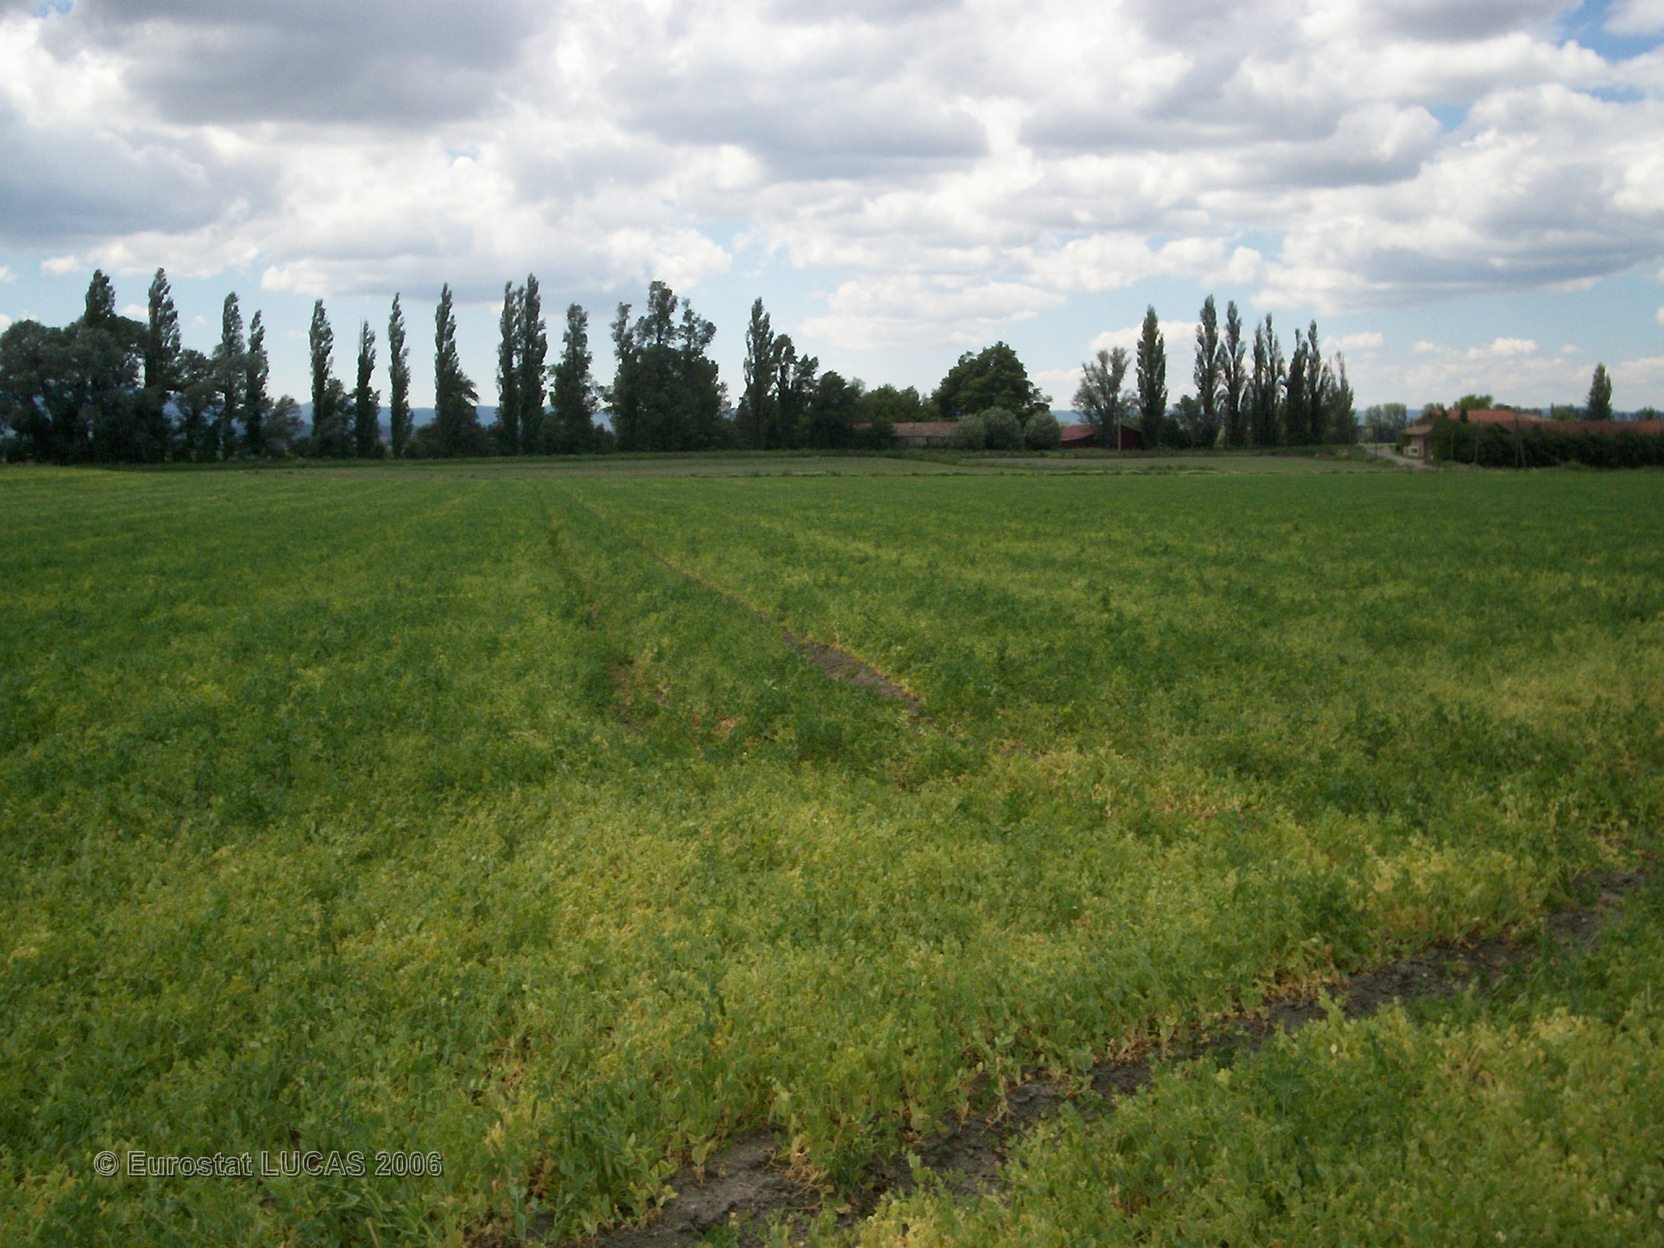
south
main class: Cropland
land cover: Dry pulses
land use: Agriculture (excluding fallow land and kitchen gardens)
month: May
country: FR
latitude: 44.6420
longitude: 4.9257
